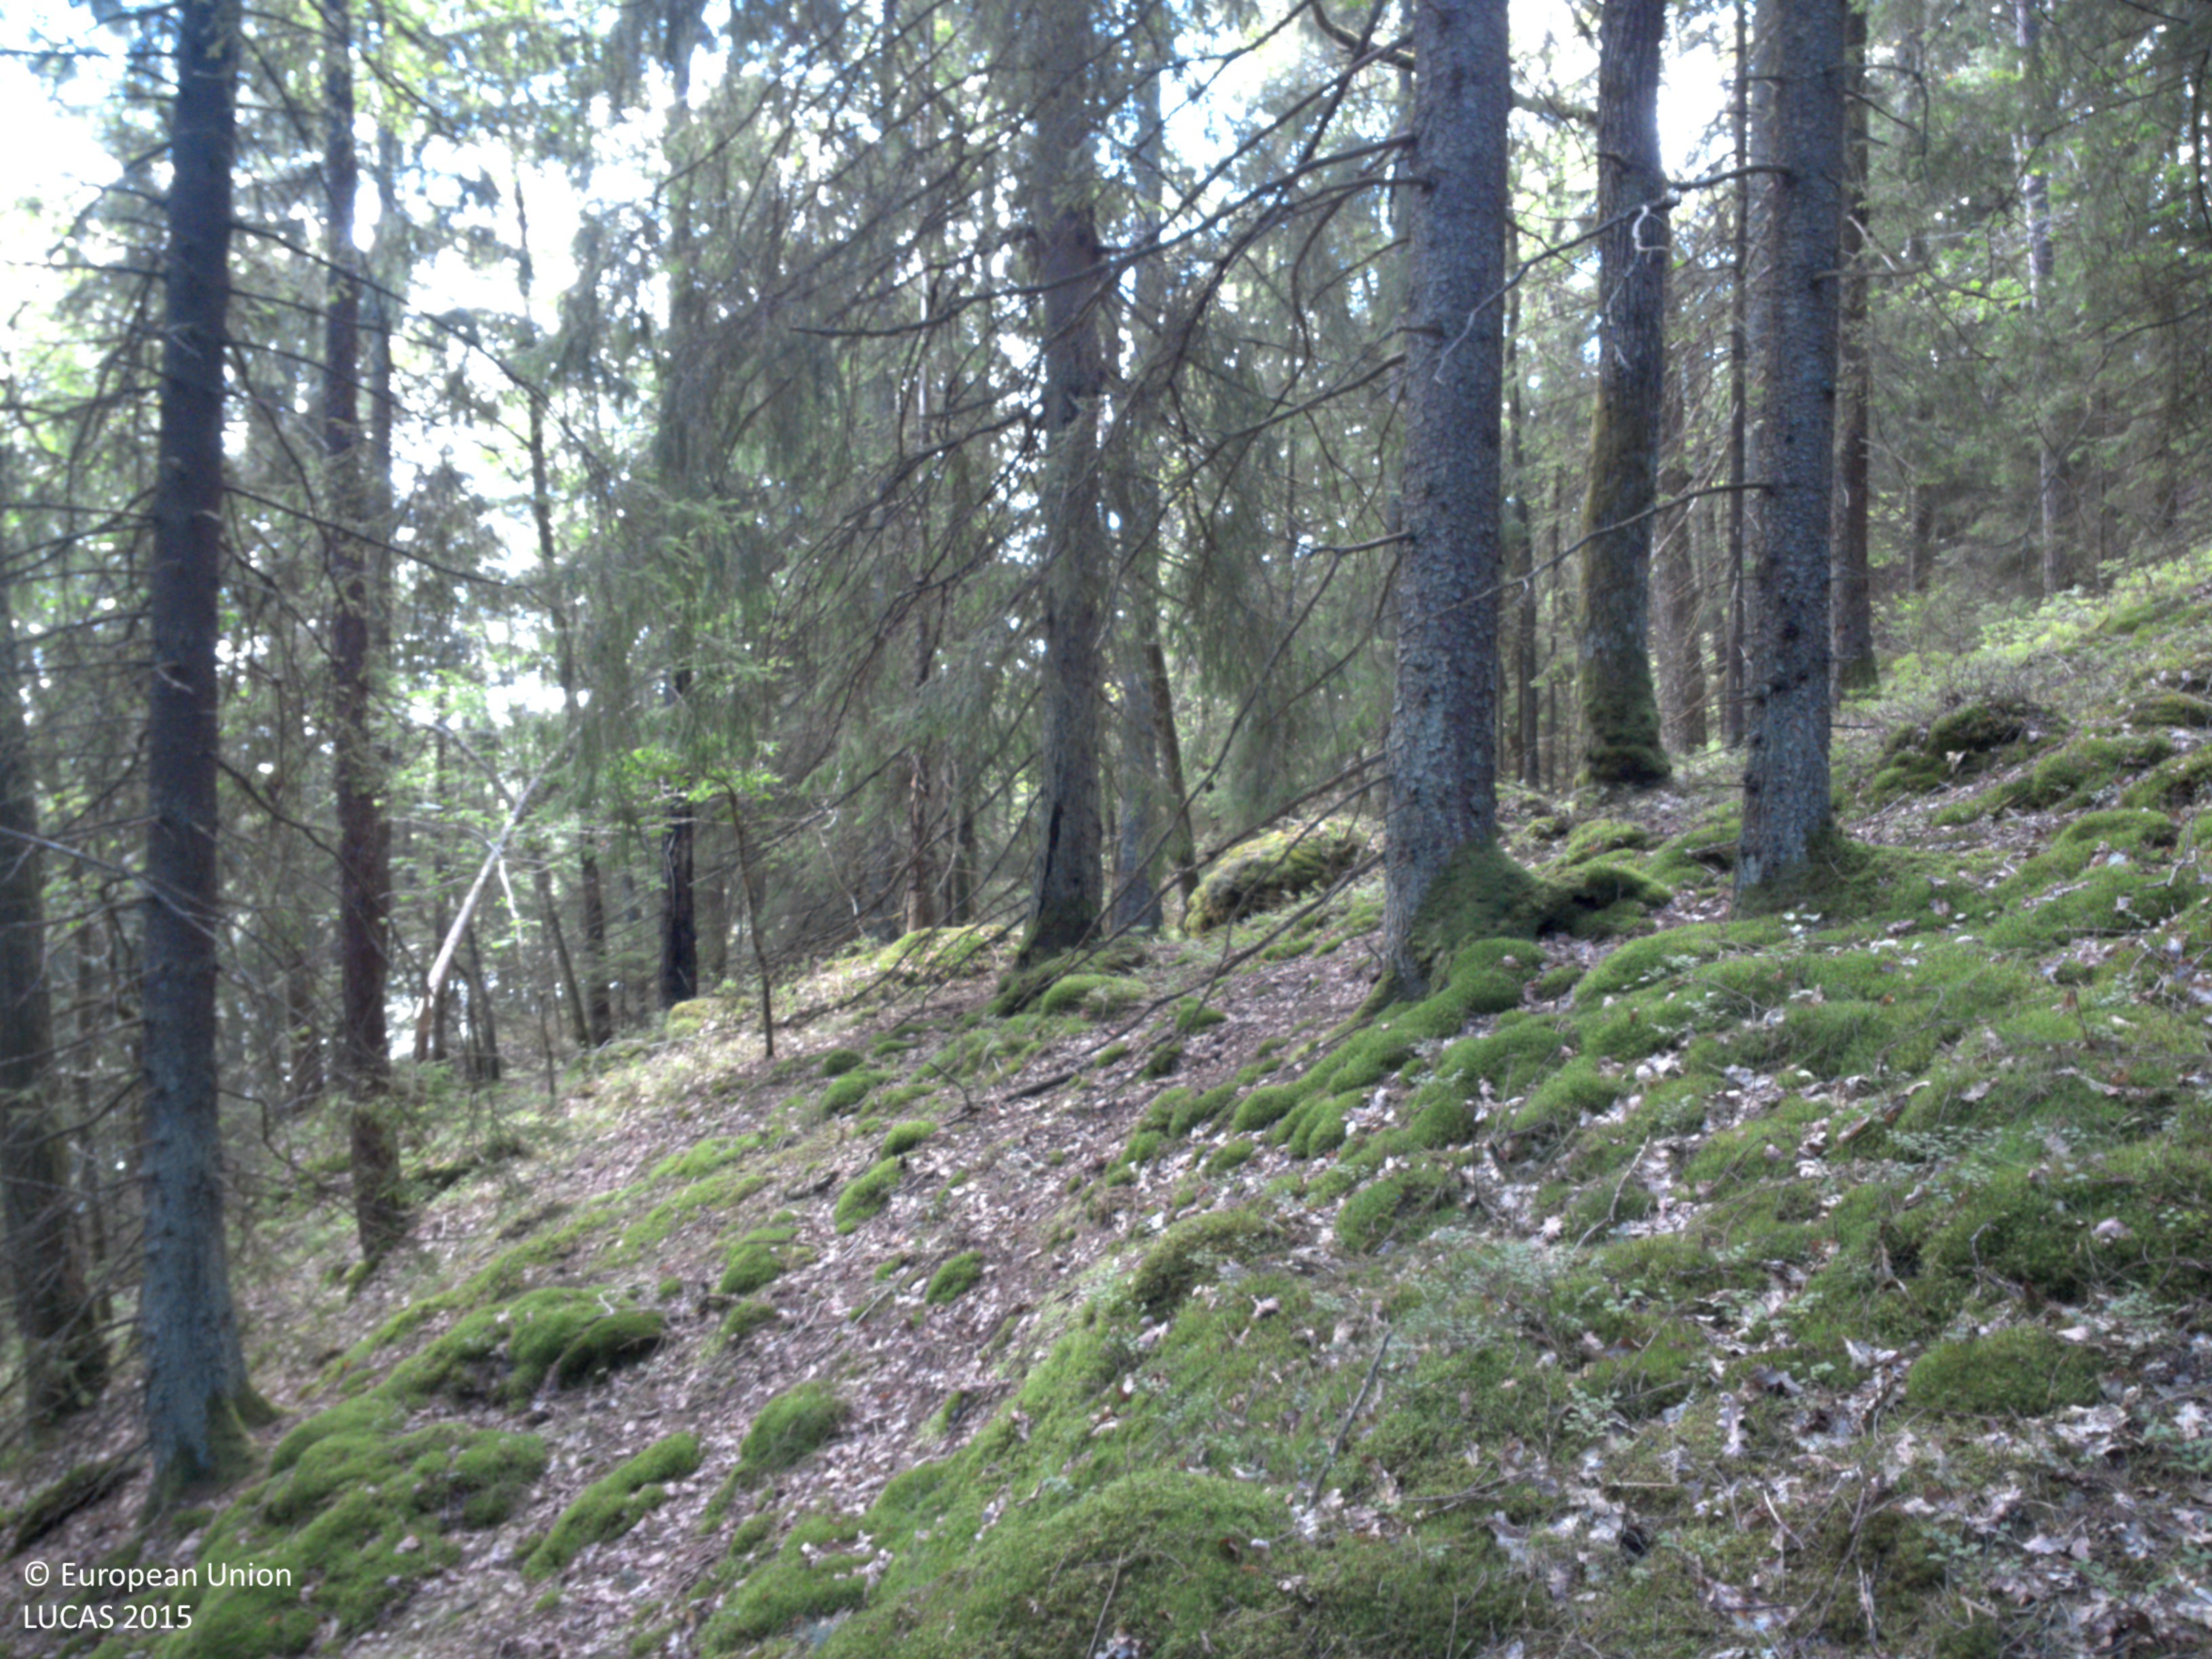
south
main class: Woodland
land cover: Spruce dominated coniferous woodland
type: boreal forest
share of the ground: 50 - 75 %
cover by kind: coniferous forest trees 60 %, herbaceous plants 25 %, shrubs 15 %
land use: Forestry
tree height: > 5 m
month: August
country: SE
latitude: 58.0430
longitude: 11.9783
